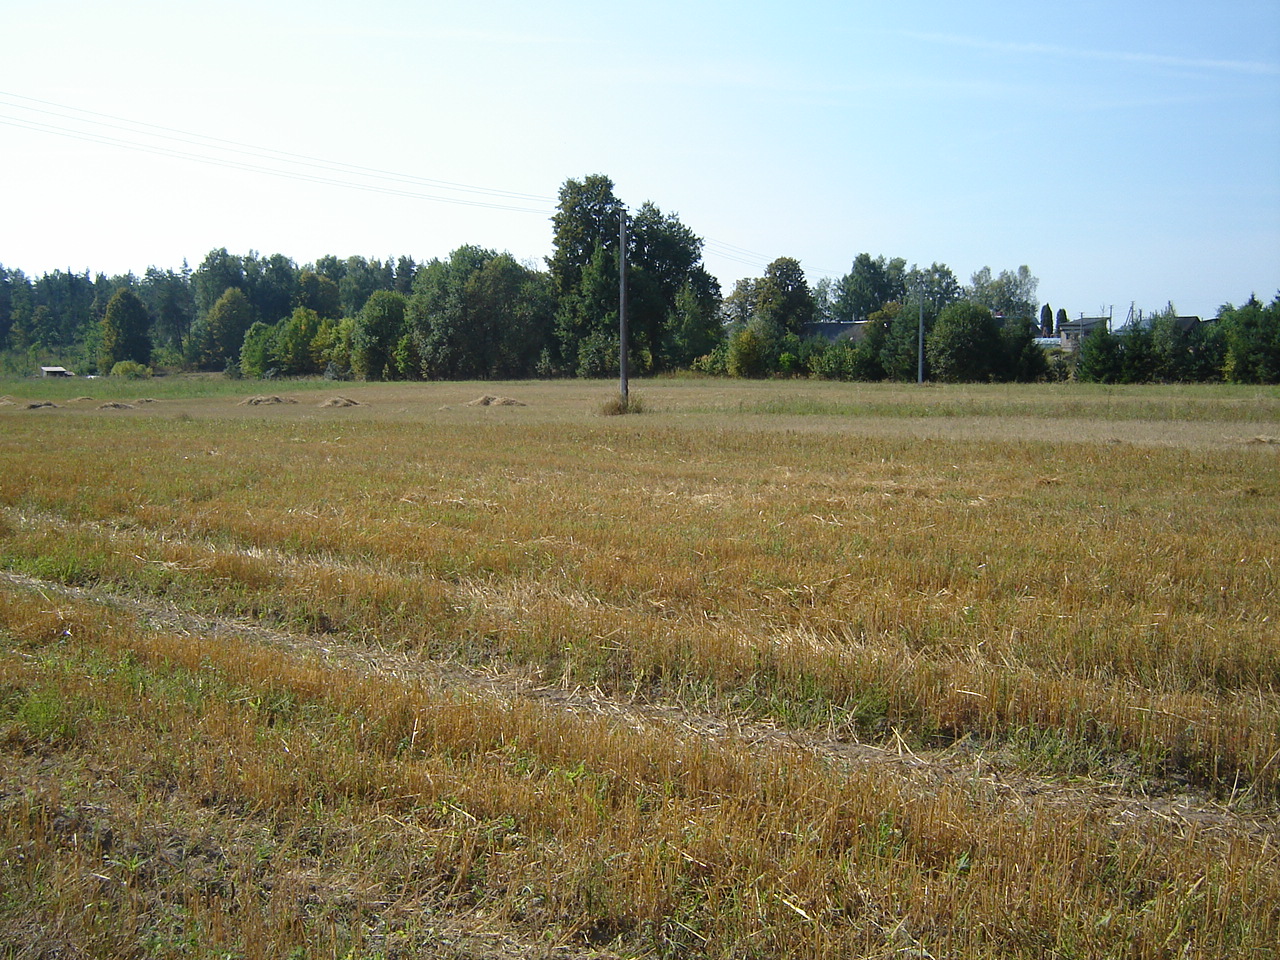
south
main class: Grassland
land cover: Grassland without tree/shrub cover
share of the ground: > 75 %
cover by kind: herbaceous plants 100 %
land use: Agriculture (excluding fallow land and kitchen gardens)
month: August
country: LT
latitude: 54.6147
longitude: 24.9001
